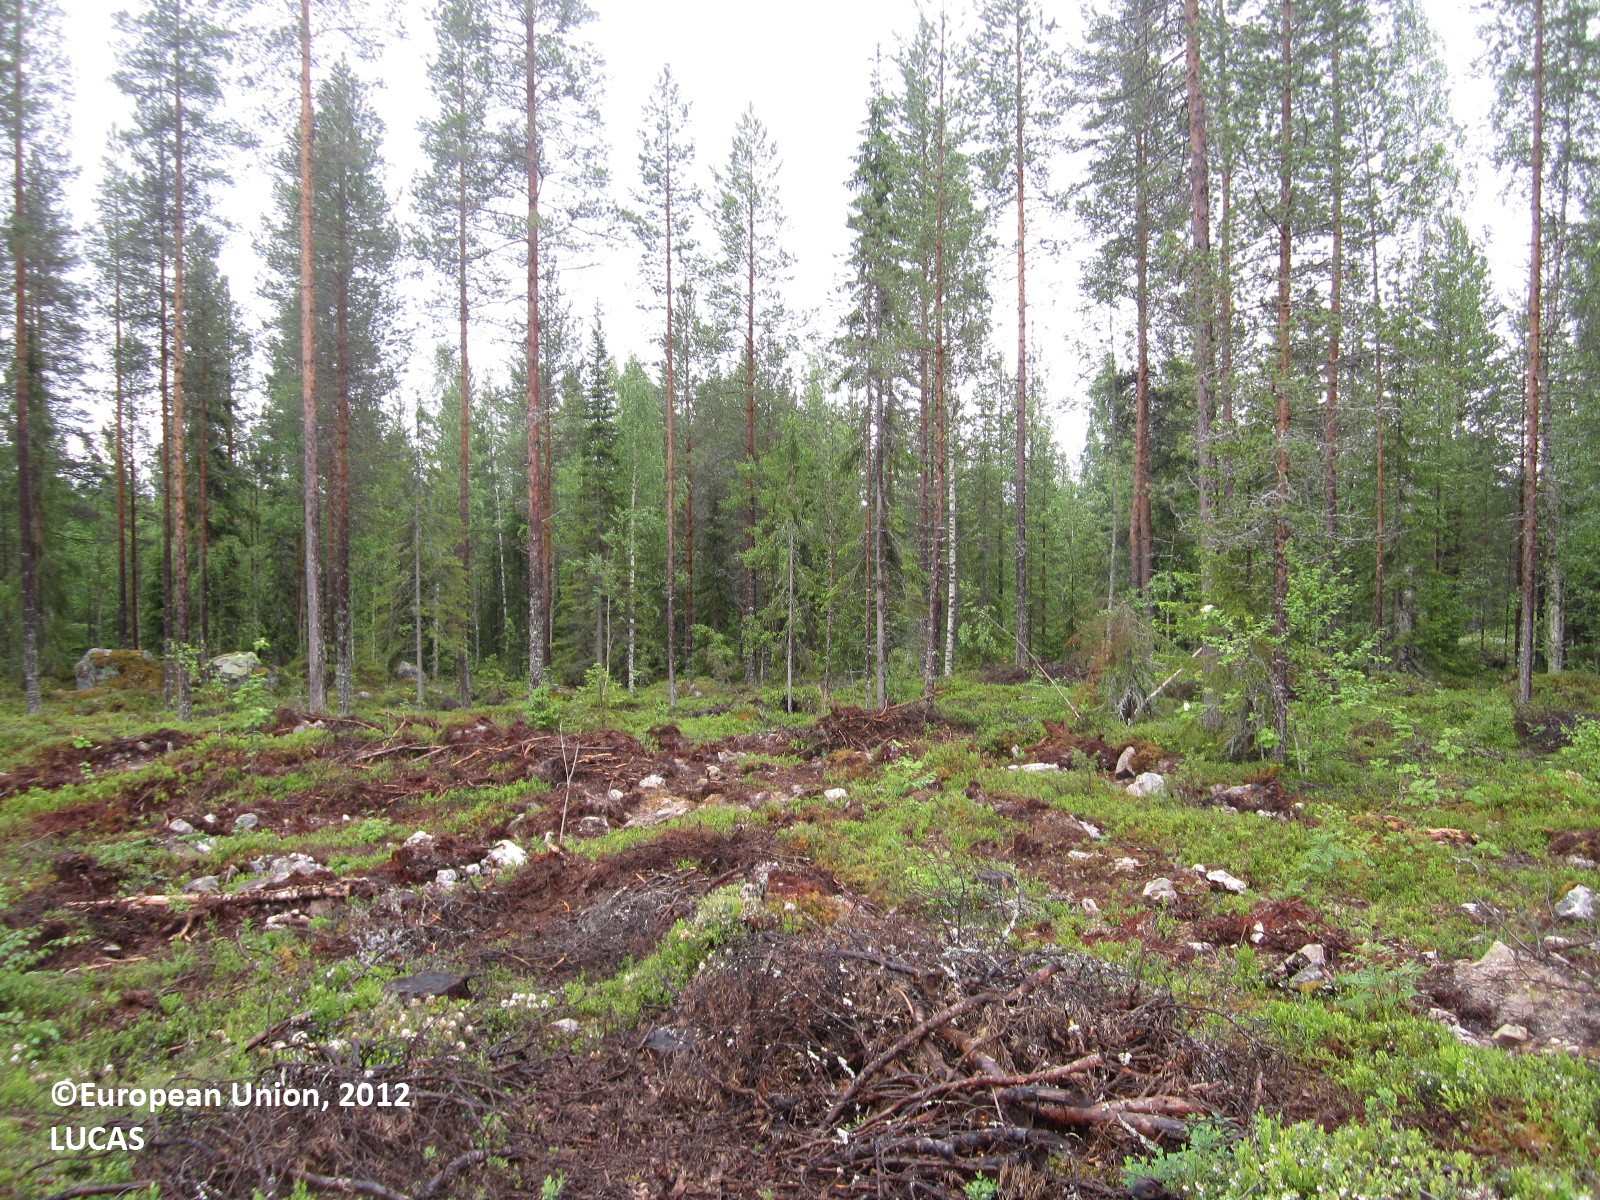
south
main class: Shrubland
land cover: Shrubland with sparse tree cover
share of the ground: 10 - 25 %
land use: Forestry
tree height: < 5 m
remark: Clear cut
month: June
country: FI
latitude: 64.2809
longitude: 29.4425
